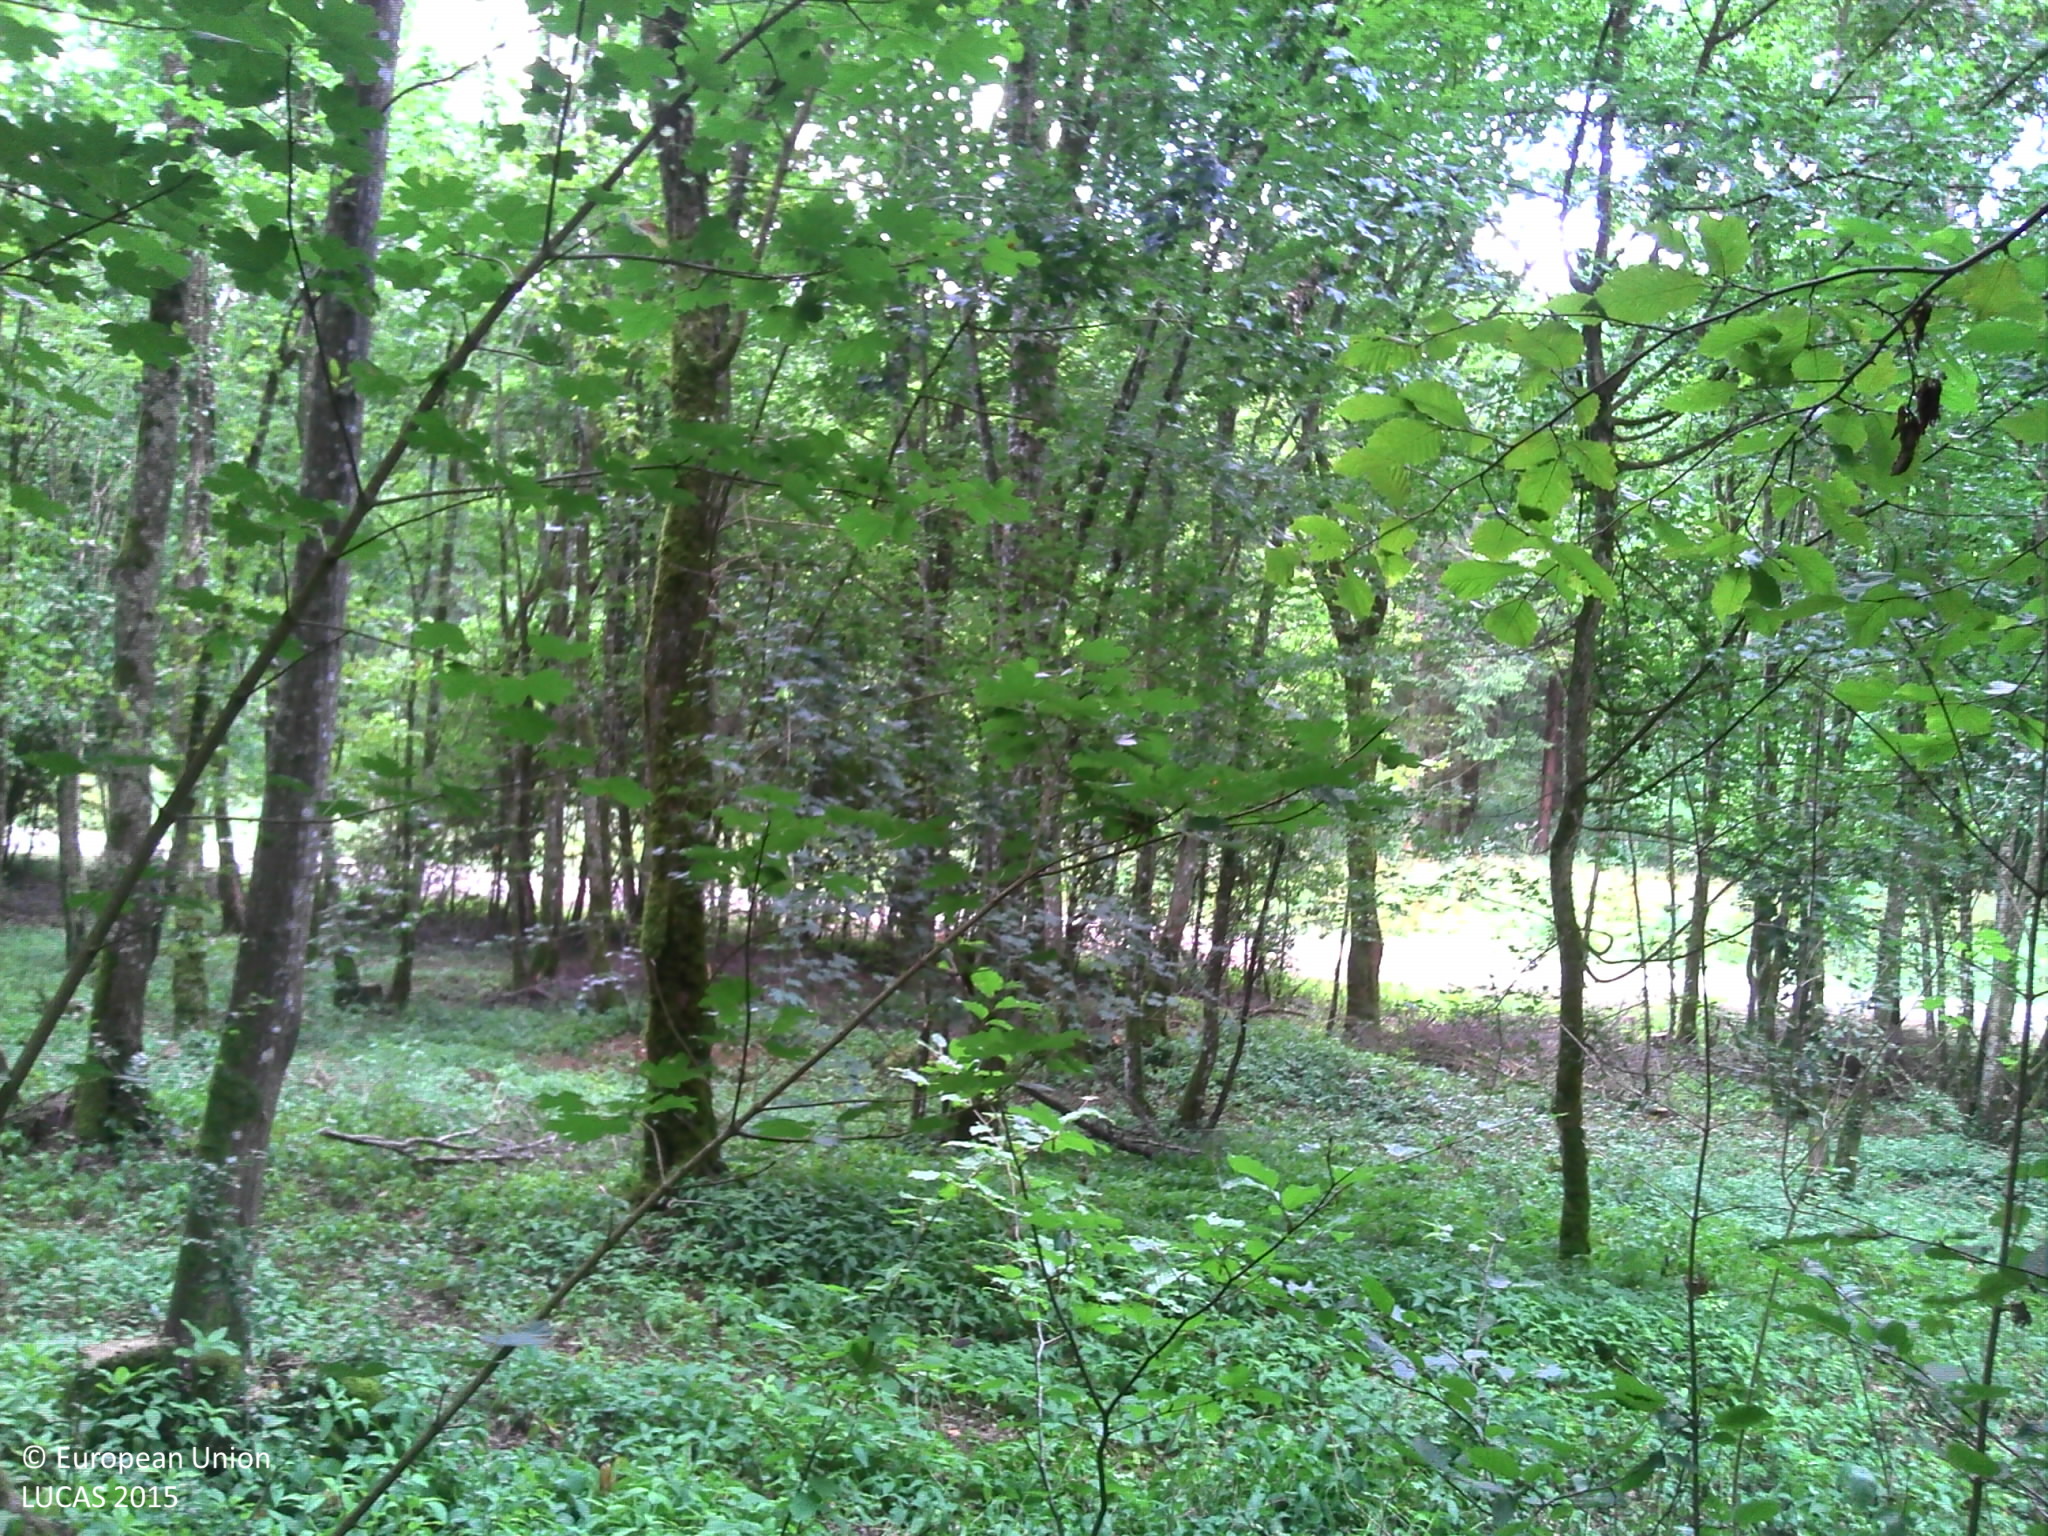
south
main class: Woodland
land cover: Broadleaved woodland
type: mesophytic deciduous forest
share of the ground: > 75 %
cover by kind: broadleaved forest trees 95 %, herbaceous plants 5 %
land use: Forestry
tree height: > 5 m
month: July
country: FR
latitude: 49.1805
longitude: 5.1554
